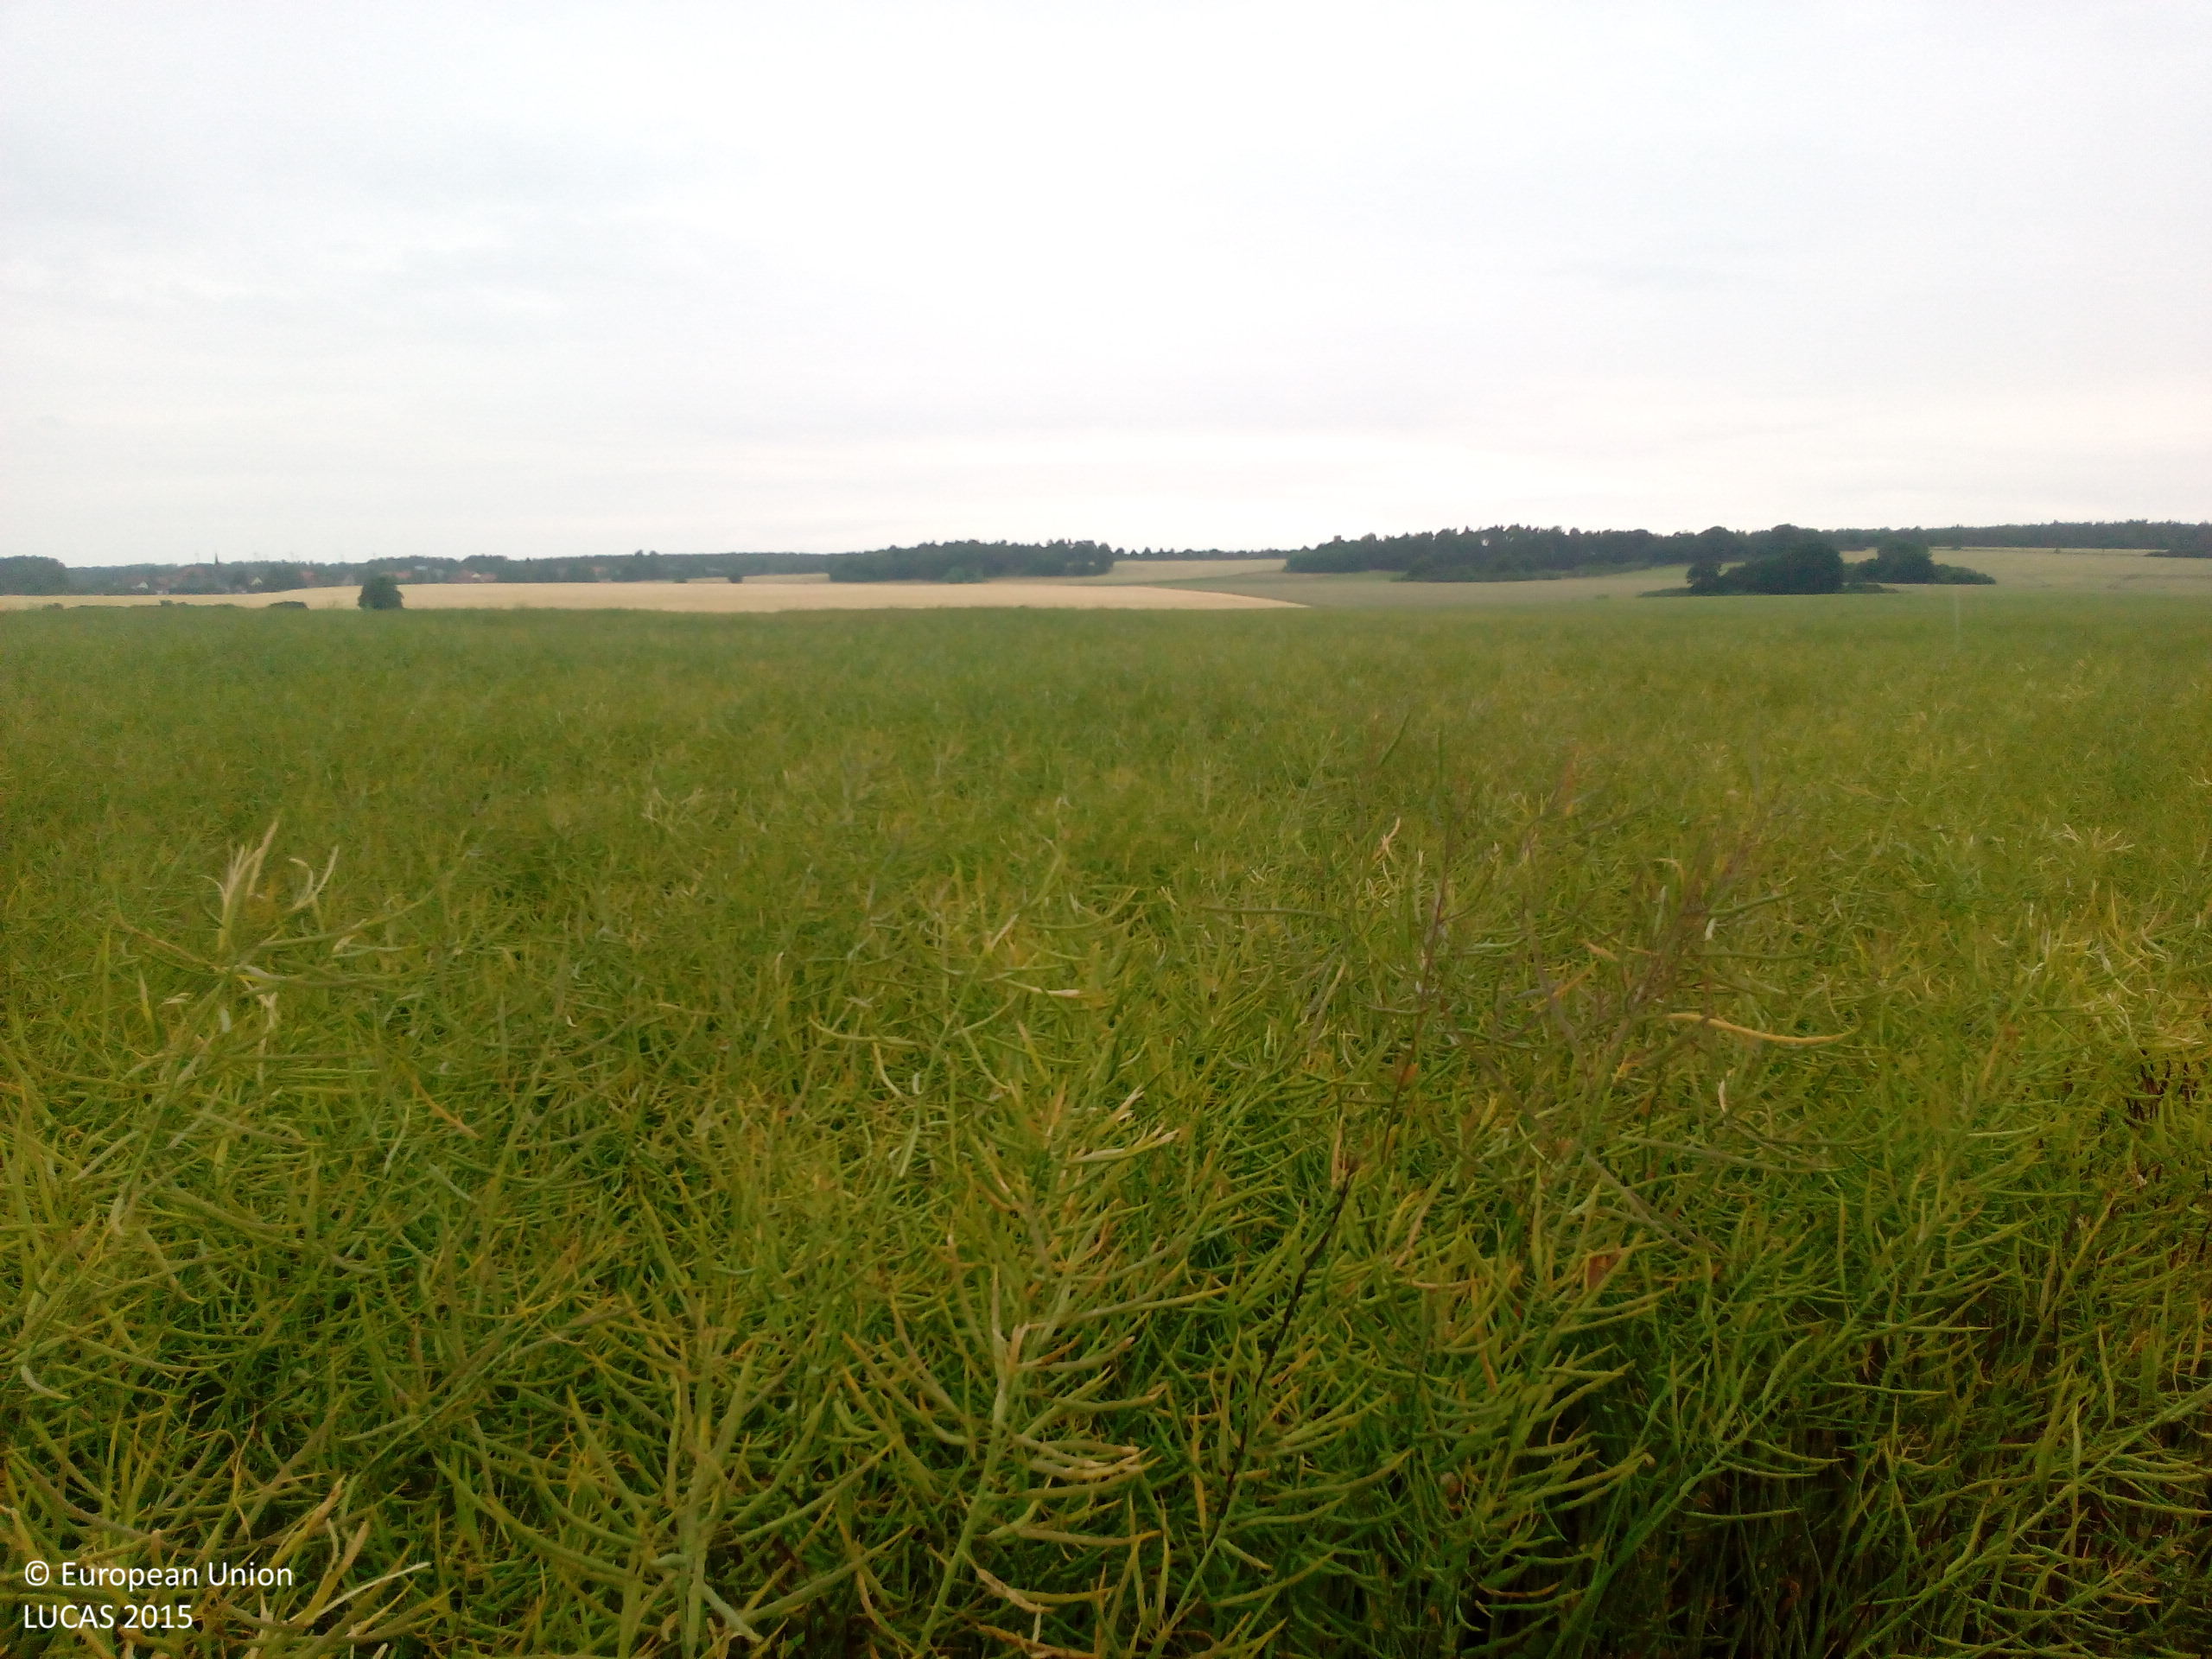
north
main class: Cropland
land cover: Rape and turnip rape
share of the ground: > 75 %
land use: Agriculture (excluding fallow land and kitchen gardens)
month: June
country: DE
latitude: 52.3361
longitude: 11.1297
